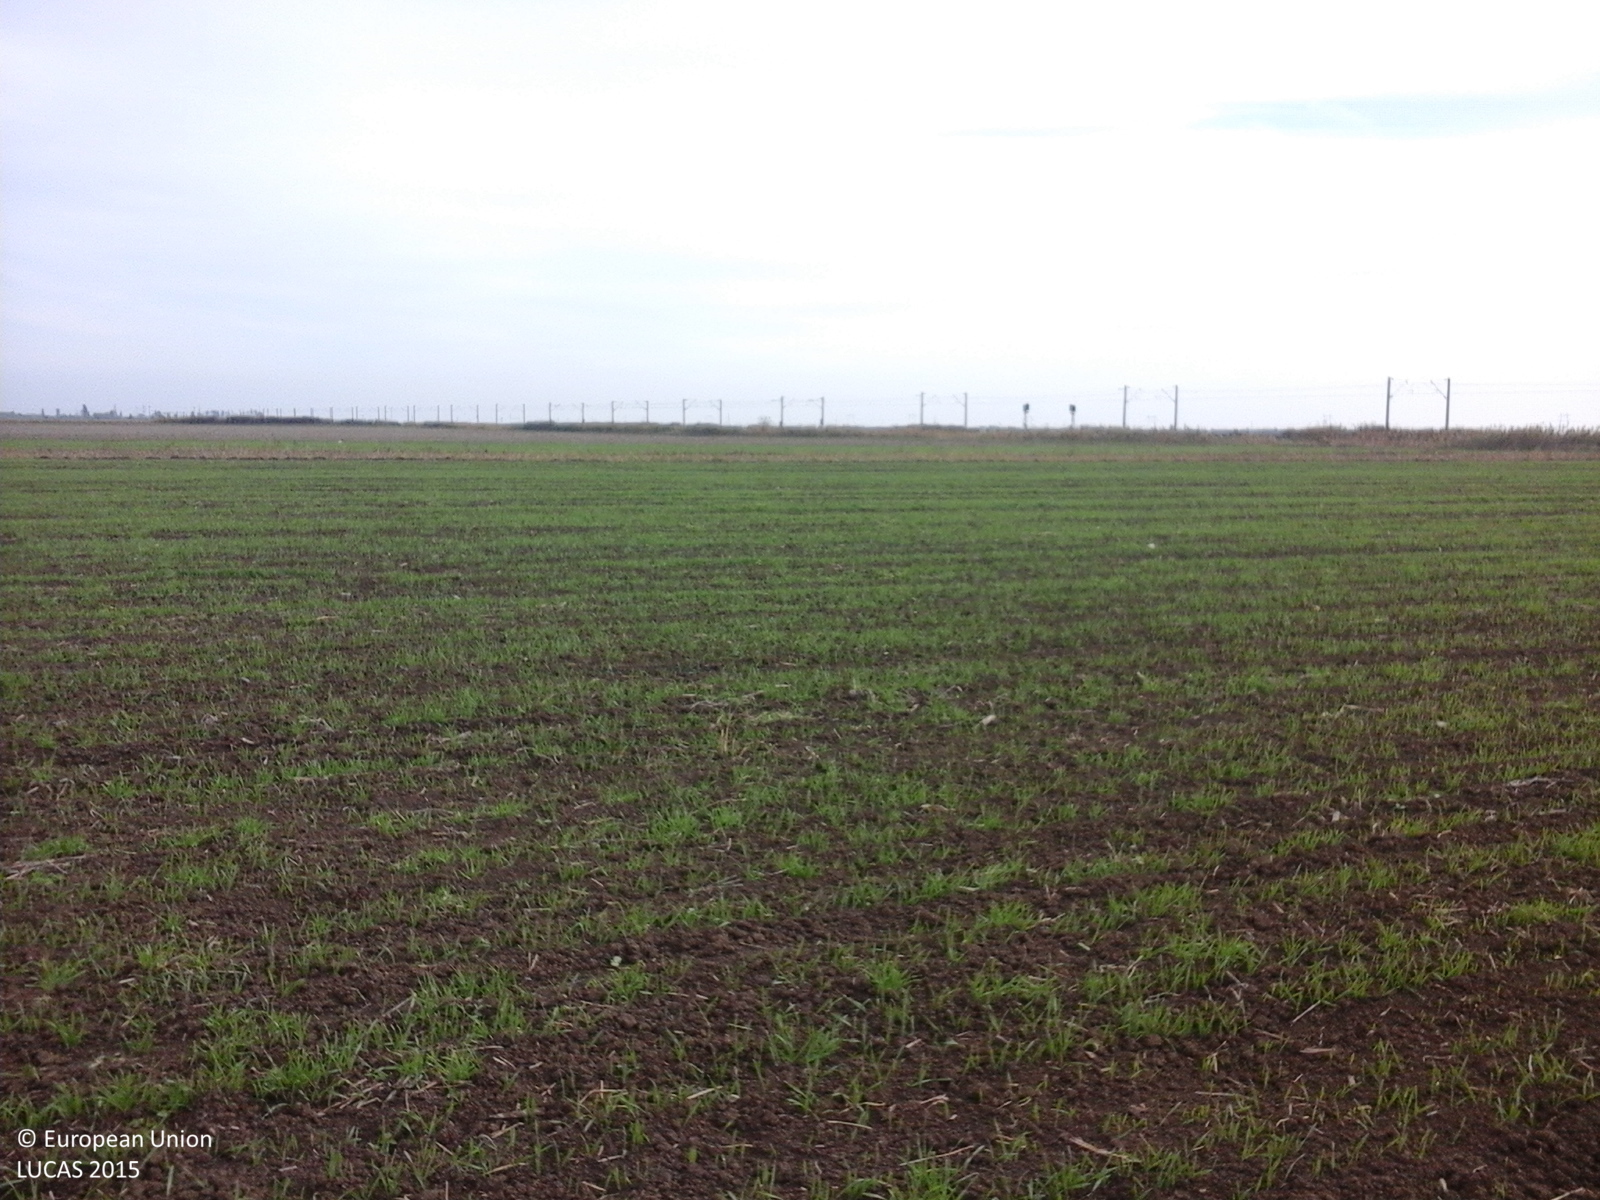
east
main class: Cropland
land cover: Common wheat
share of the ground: 50 - 75 %
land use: Agriculture (excluding fallow land and kitchen gardens)
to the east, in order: Common wheat; Maize; Common wheat
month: October
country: RO
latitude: 44.9842
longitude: 26.3892
